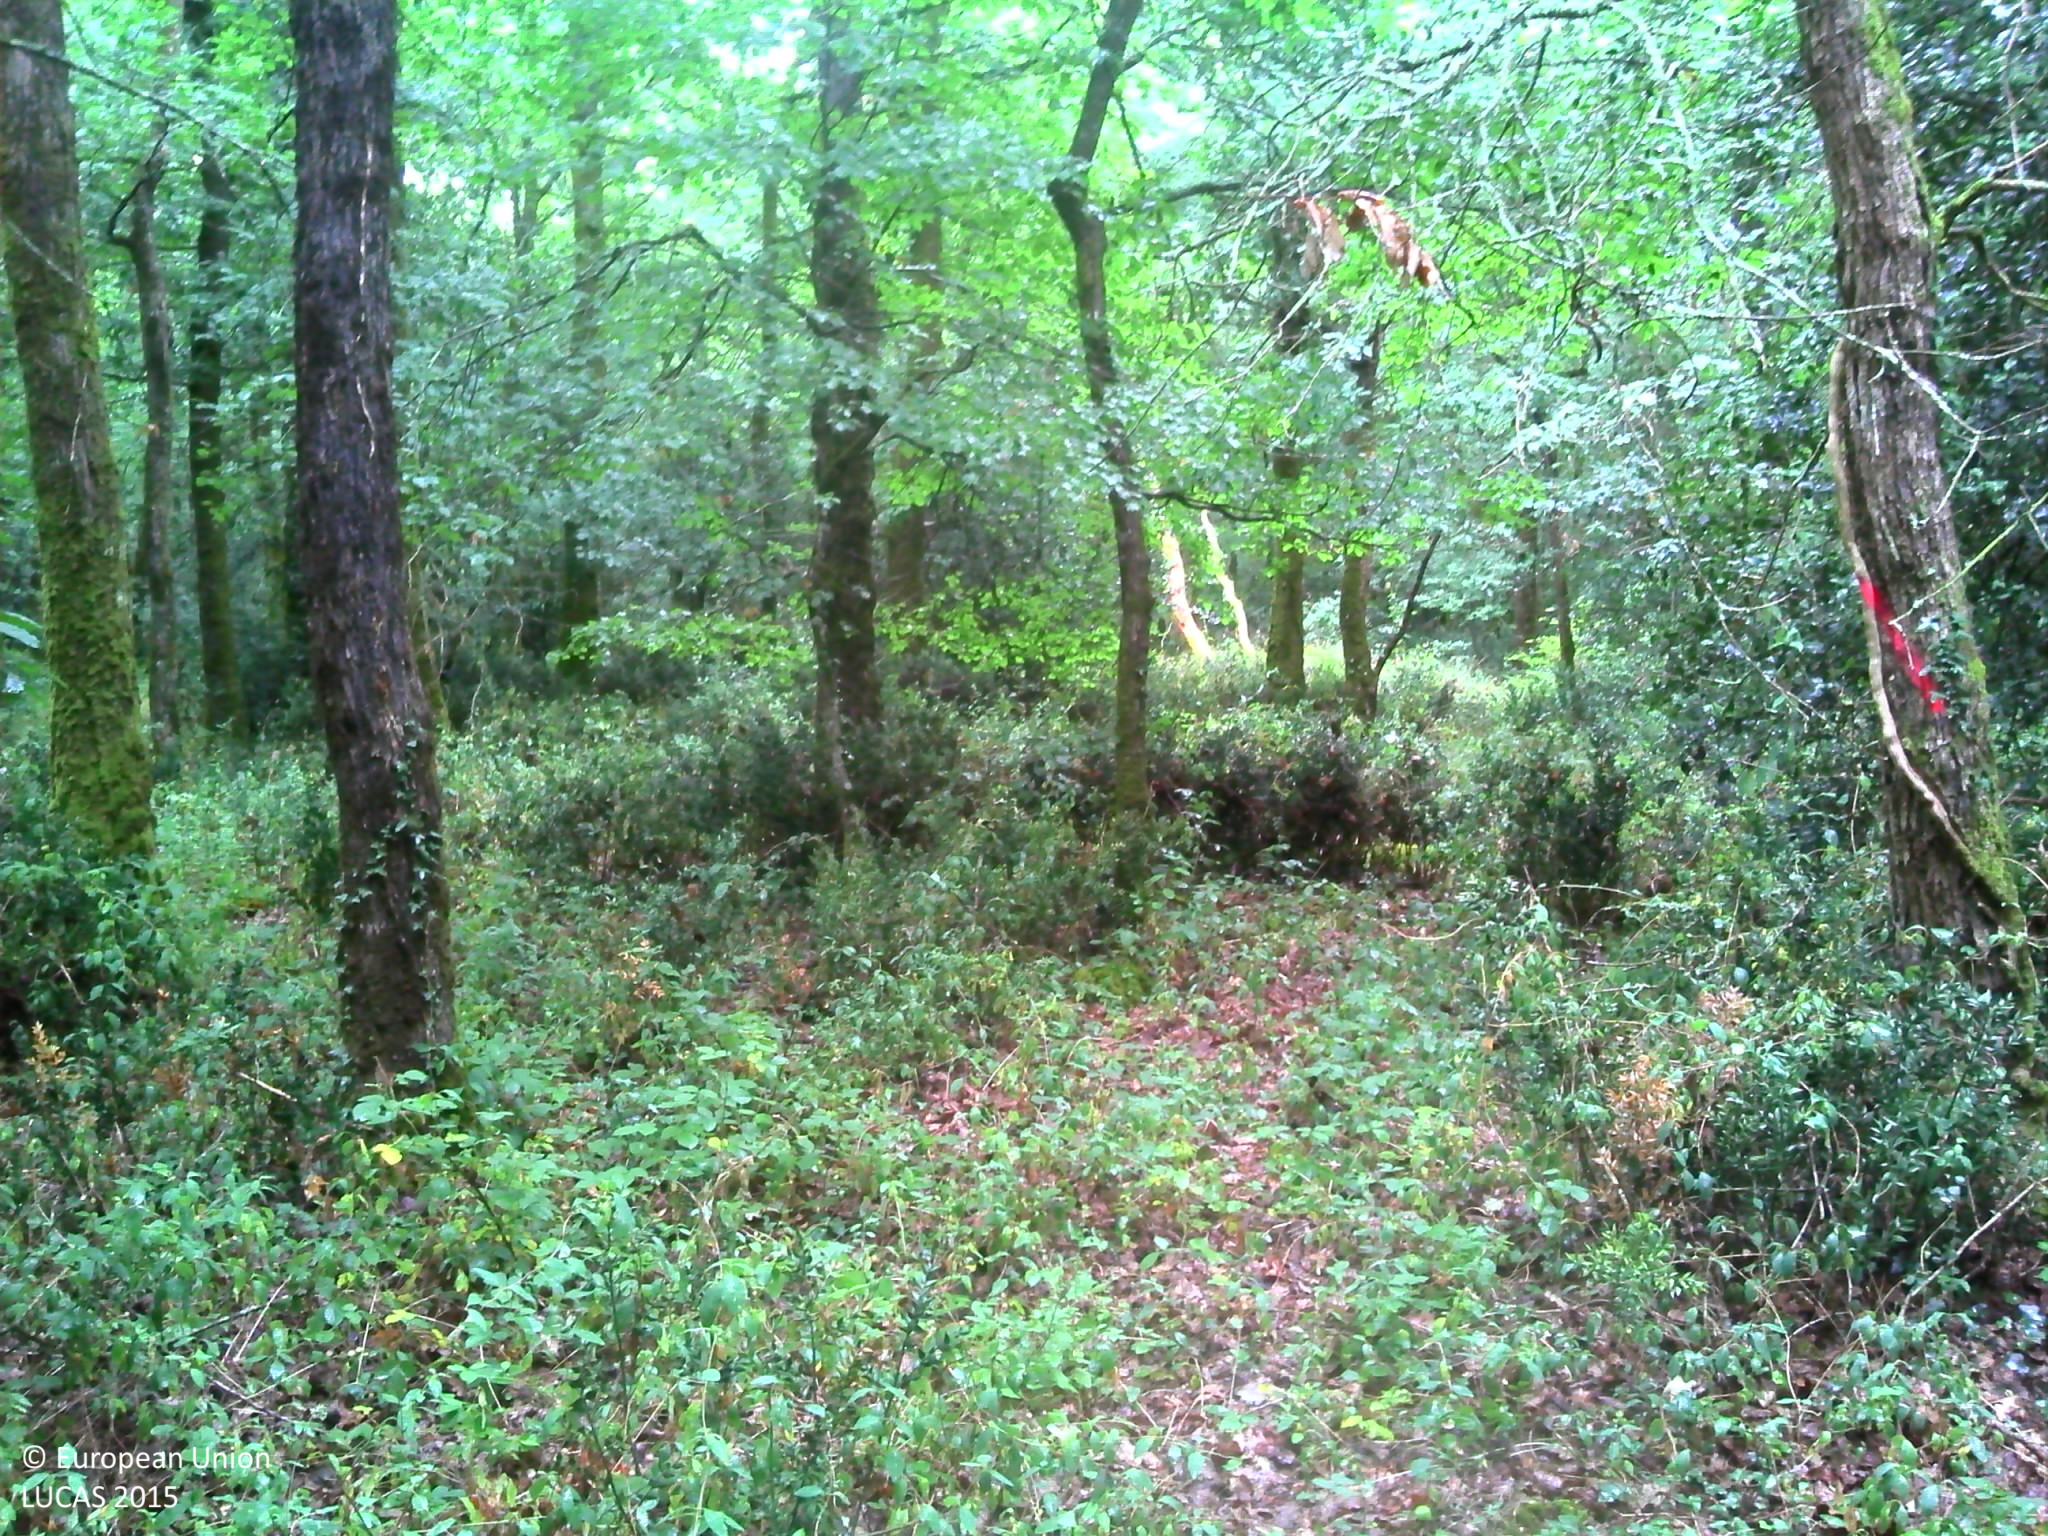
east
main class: Woodland
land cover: Broadleaved woodland
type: acidophilous oak and oak-birch forest
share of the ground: > 75 %
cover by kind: broadleaved forest trees 95 %, herbaceous plants 5 %
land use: Forestry
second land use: Amenities, museums, leisure
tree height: > 5 m
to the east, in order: Broadleaved woodland
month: July
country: FR
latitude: 47.4969
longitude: -1.7946
